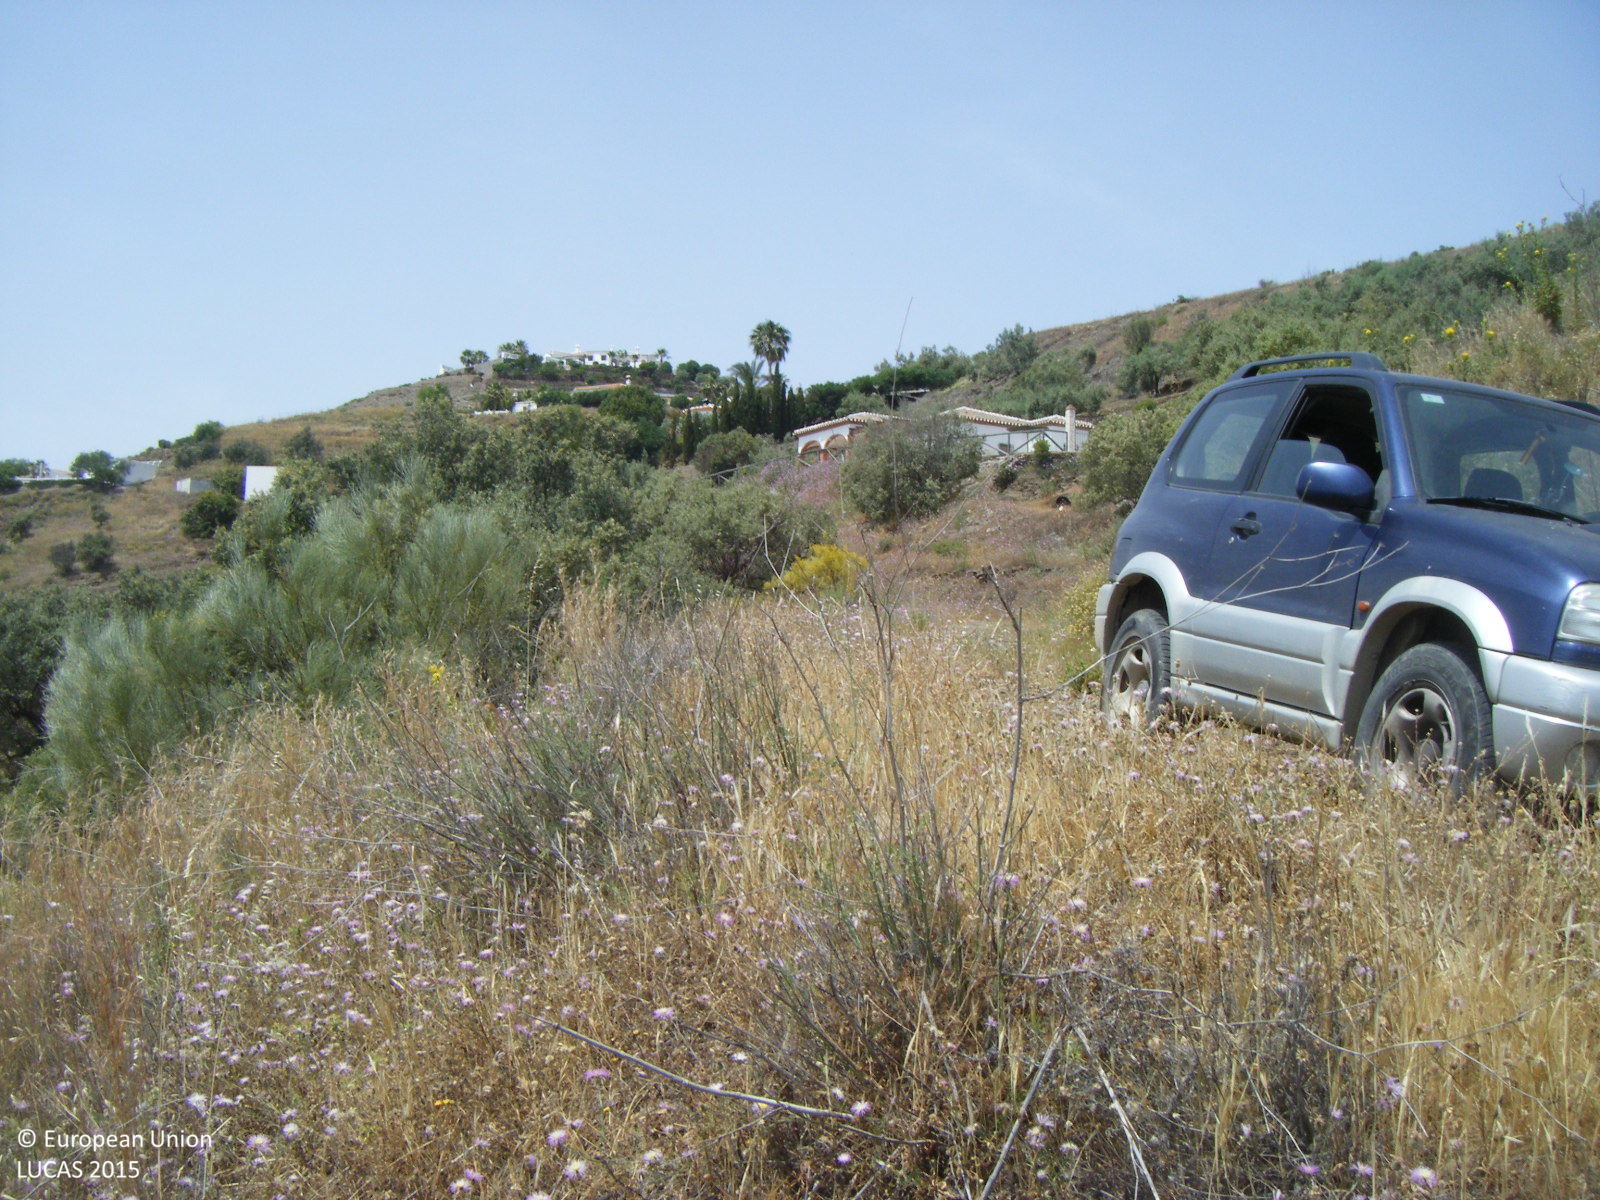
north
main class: Grassland
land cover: Grassland without tree/shrub cover
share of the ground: > 75 %
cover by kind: herbaceous plants 95 %, shrubs 5 %
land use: Semi-natural and natural areas not in use
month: May
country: ES
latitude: 36.7793
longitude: -4.0036
